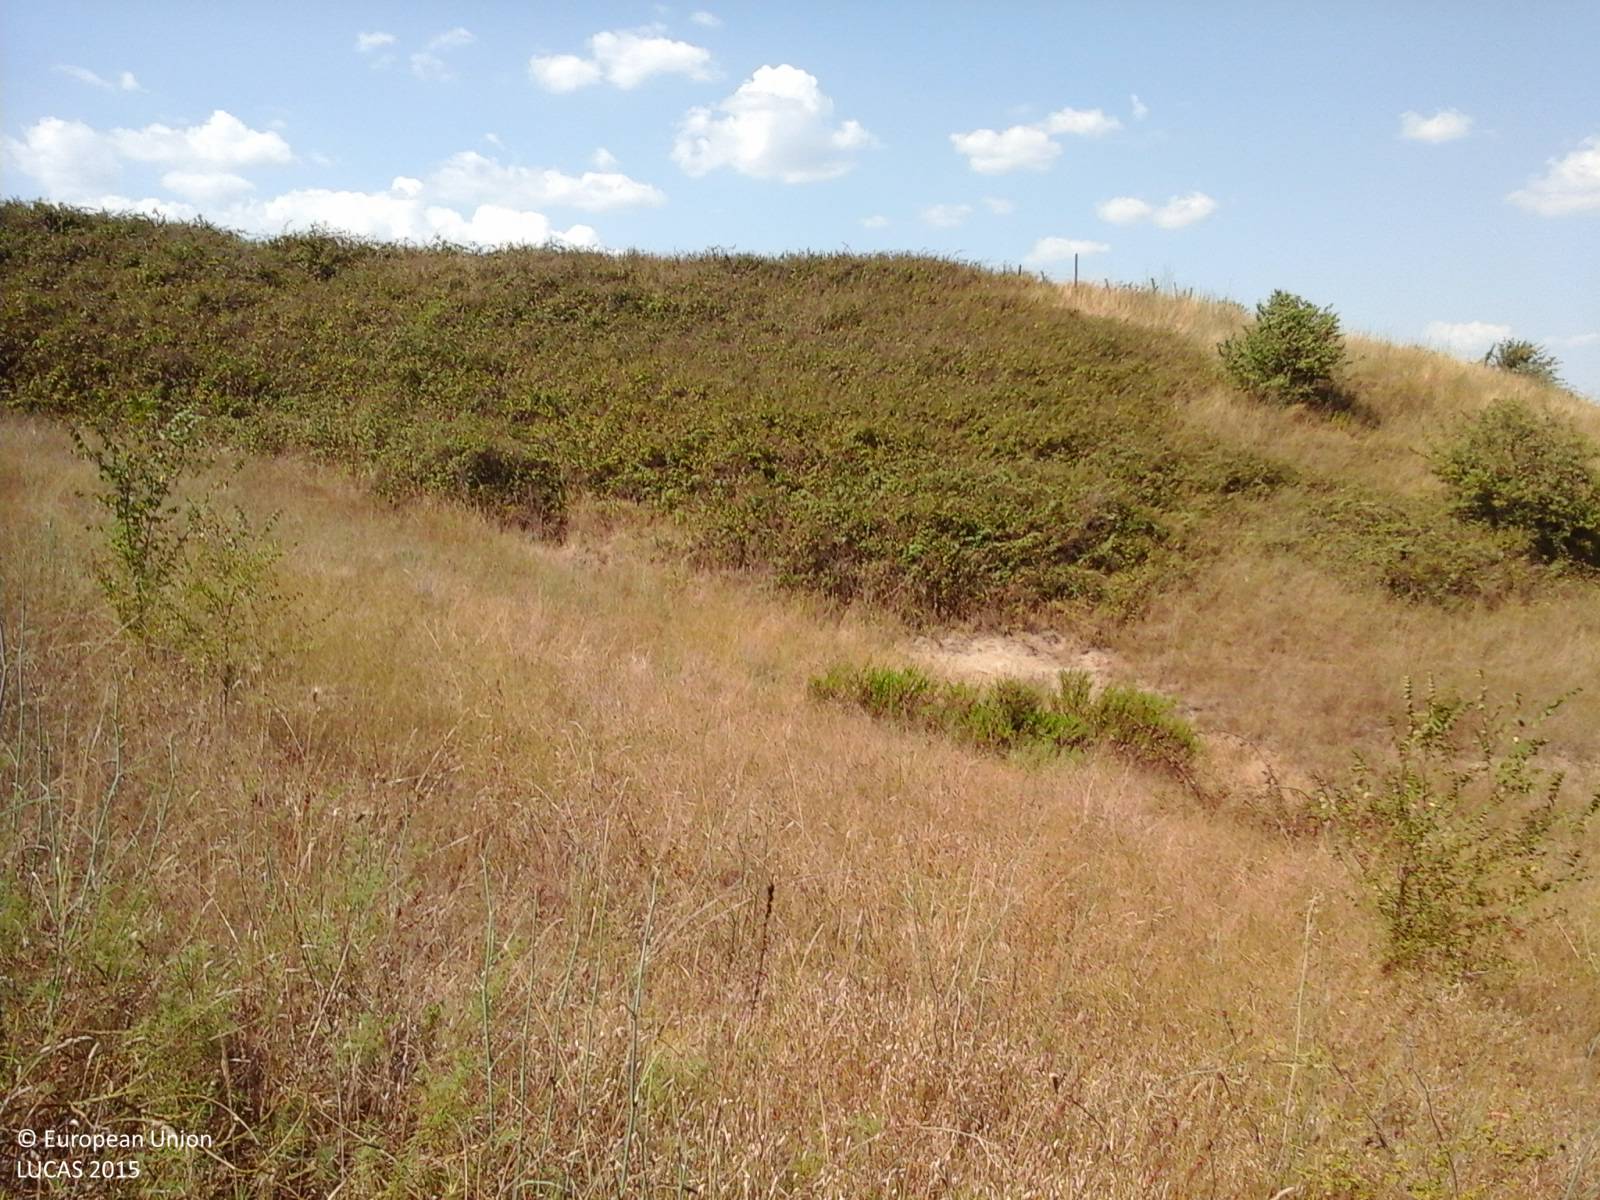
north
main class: Grassland
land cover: Grassland without tree/shrub cover
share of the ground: > 75 %
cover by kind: herbaceous plants 100 %
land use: Agriculture (excluding fallow land and kitchen gardens)
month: August
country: IT
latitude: 42.0688
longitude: 12.2518
